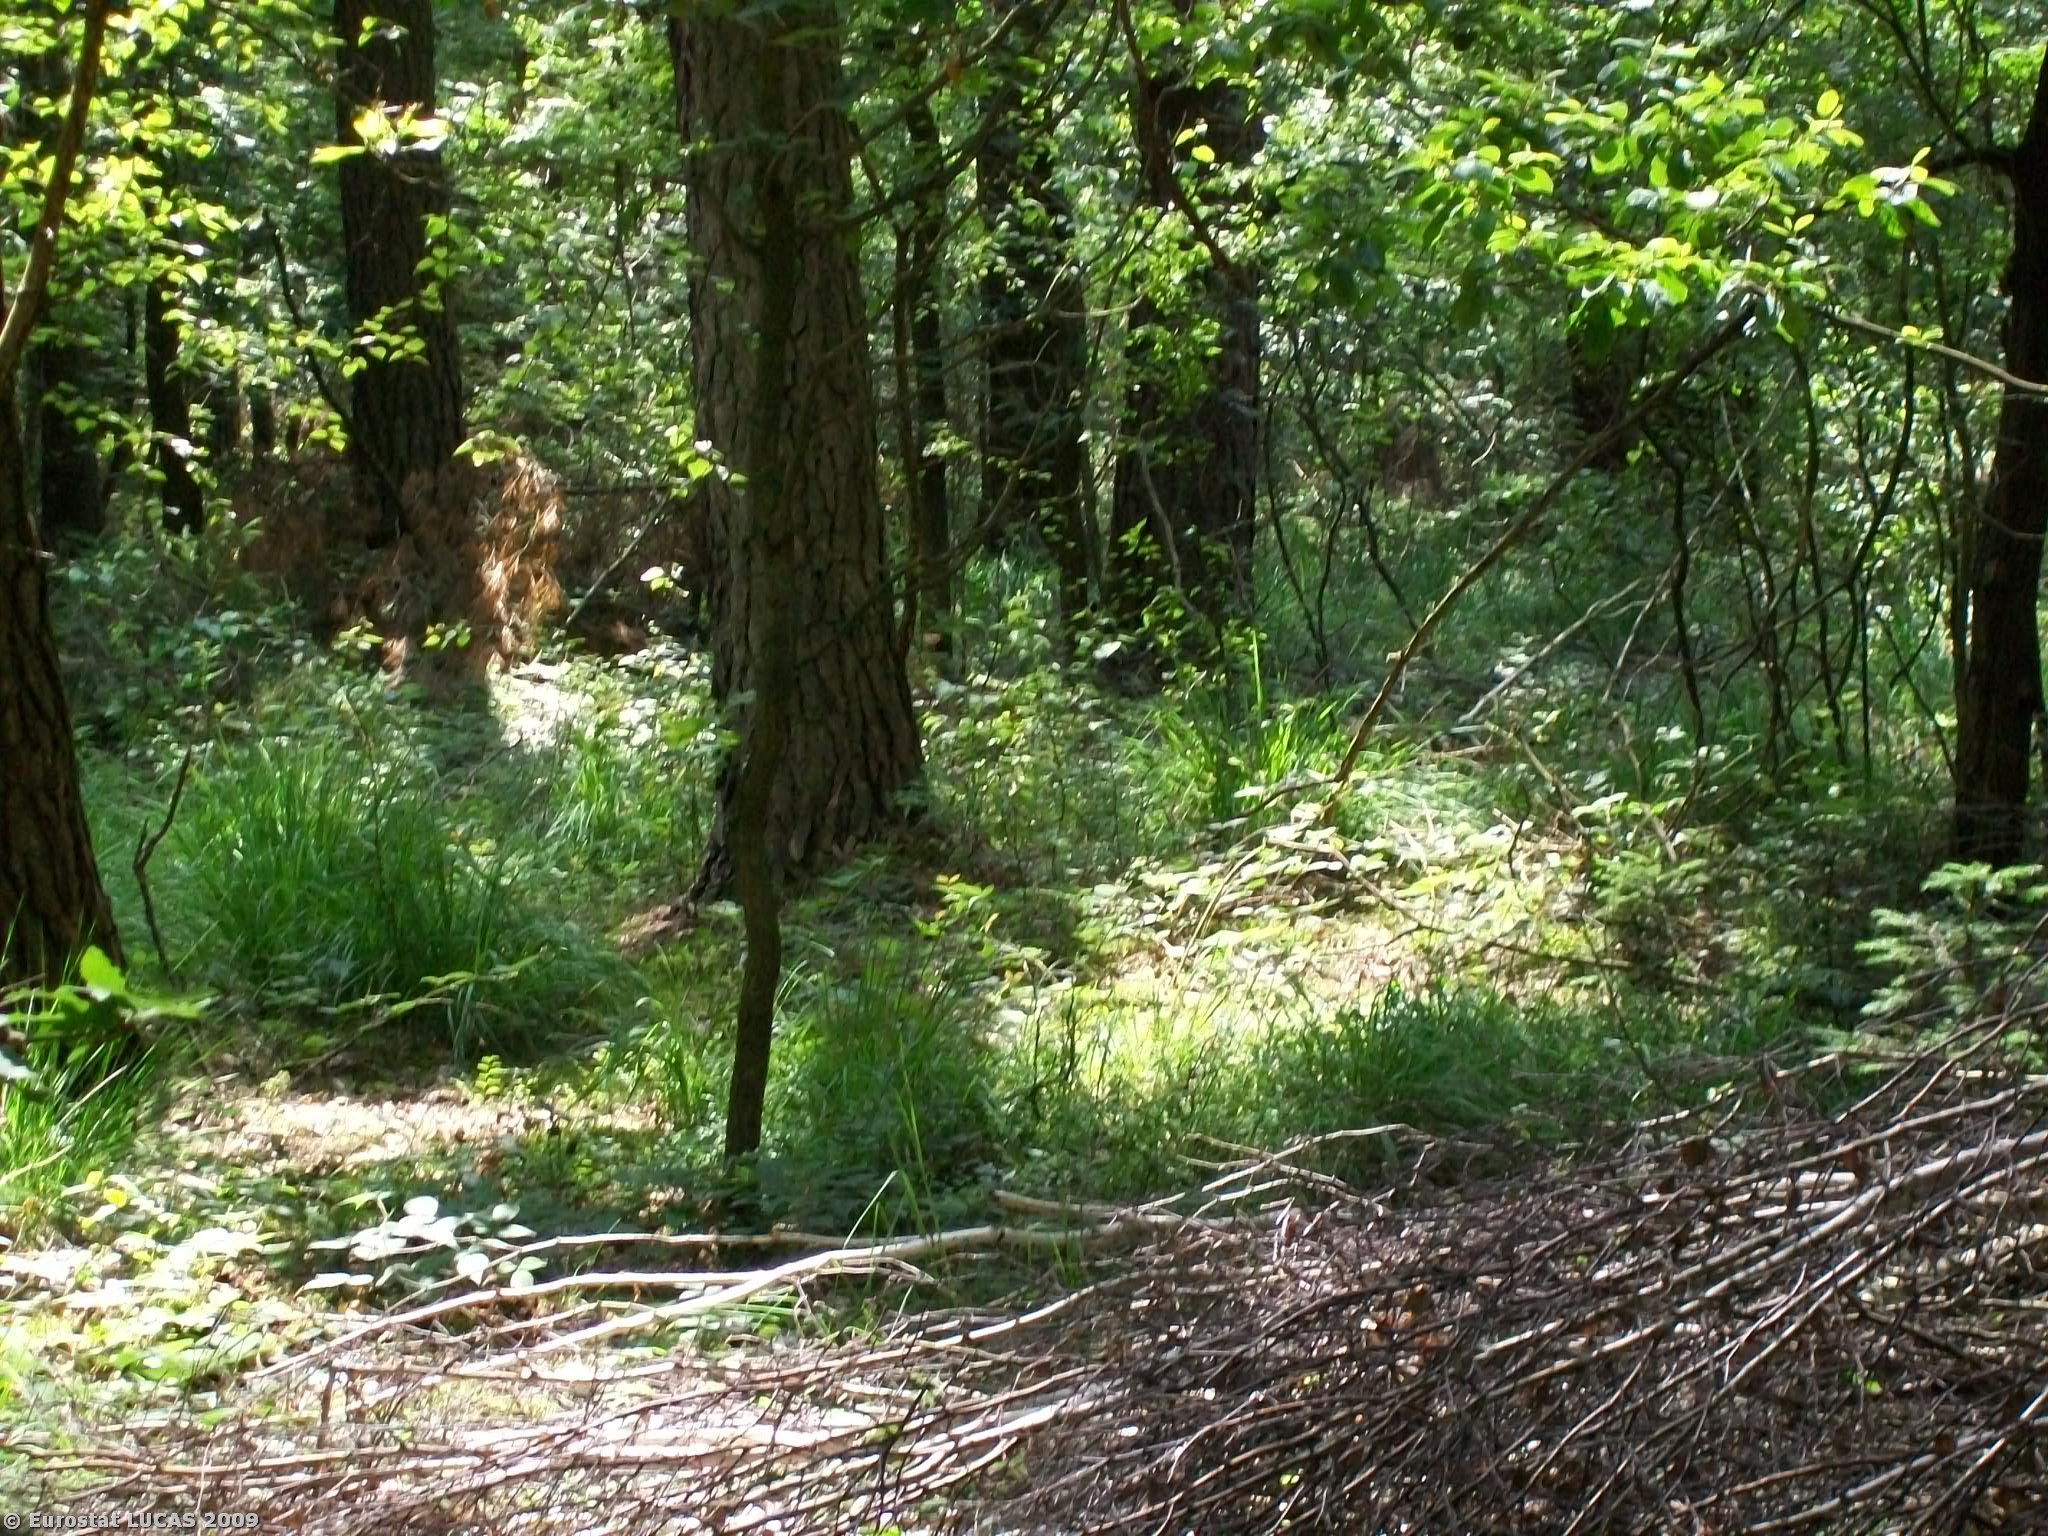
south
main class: Woodland
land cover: Coniferous woodland
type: hemiboreal forest and nemoral coniferous forest and mixed broadleaved-coniferous forest
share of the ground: > 75 %
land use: Unused
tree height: > 5 m
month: July
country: PL
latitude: 51.1898
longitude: 16.8056
